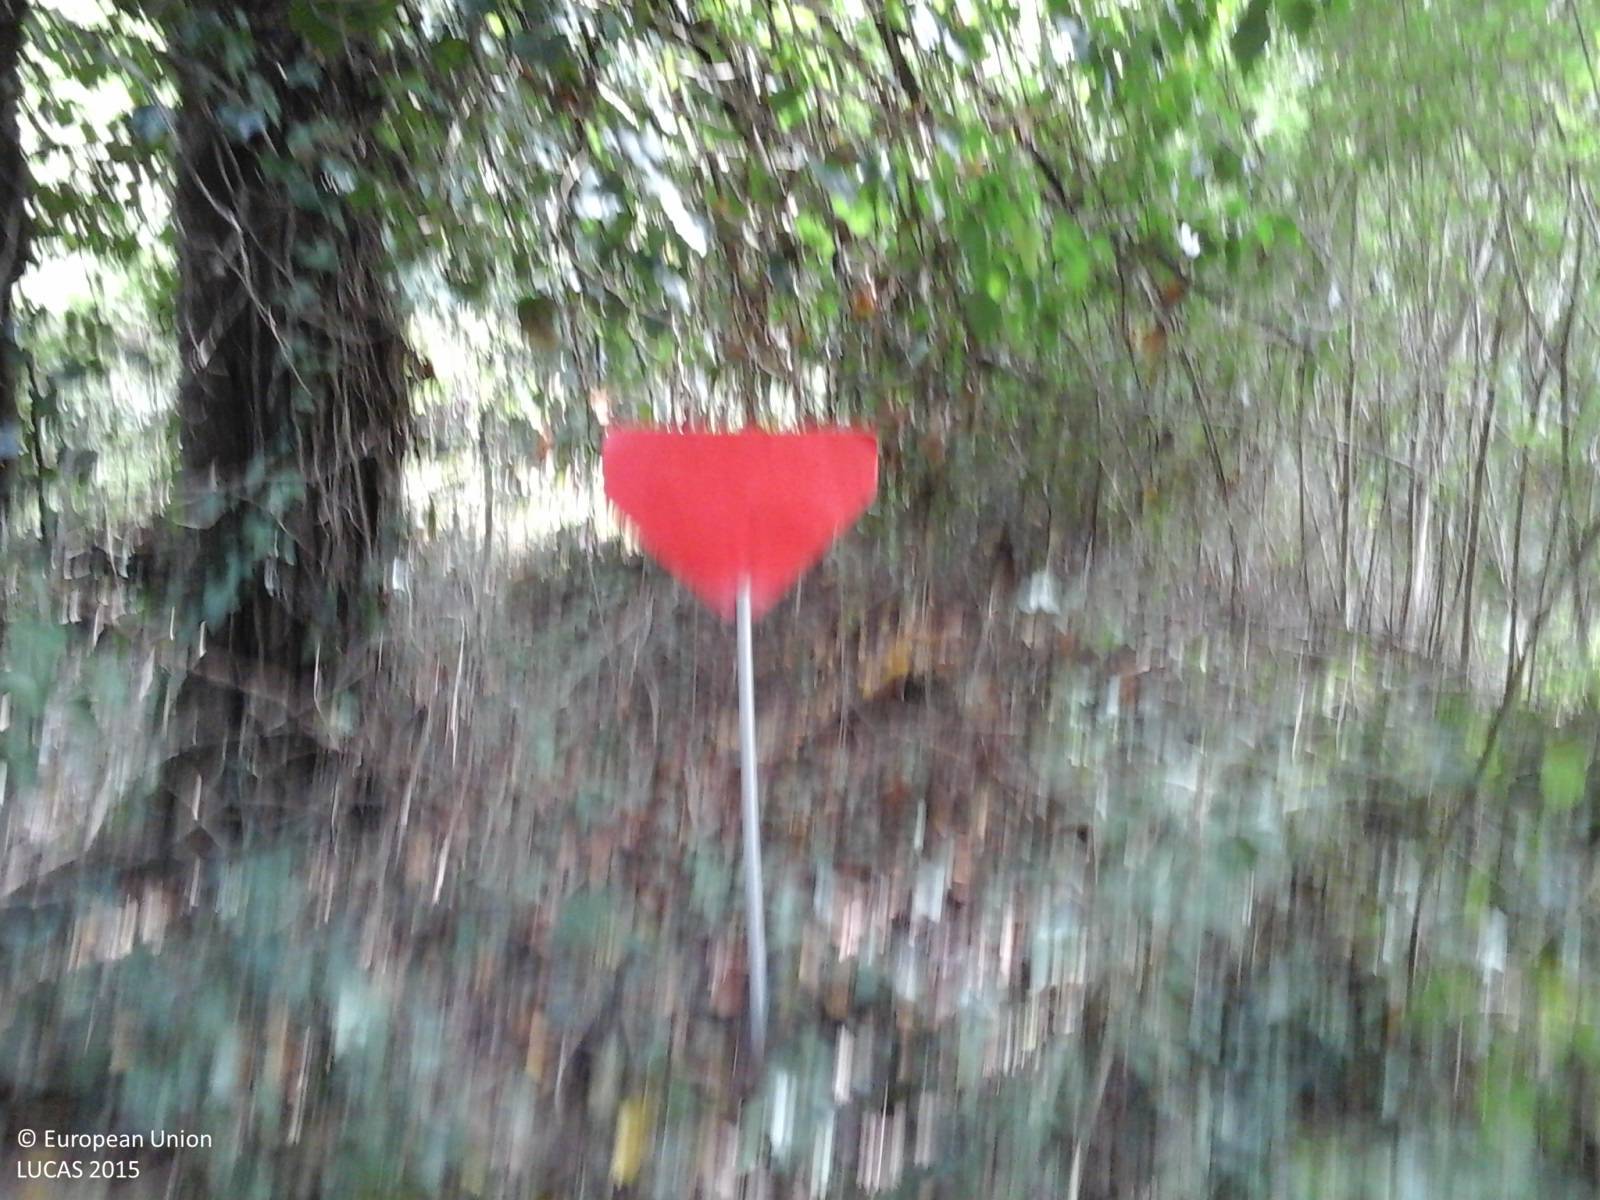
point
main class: Woodland
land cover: Broadleaved woodland
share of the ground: > 75 %
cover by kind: broadleaved forest trees 80 %, shrubs 20 %
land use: Forestry
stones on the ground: < 10 %
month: September
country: IT
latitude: 42.9757
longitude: 12.0905
